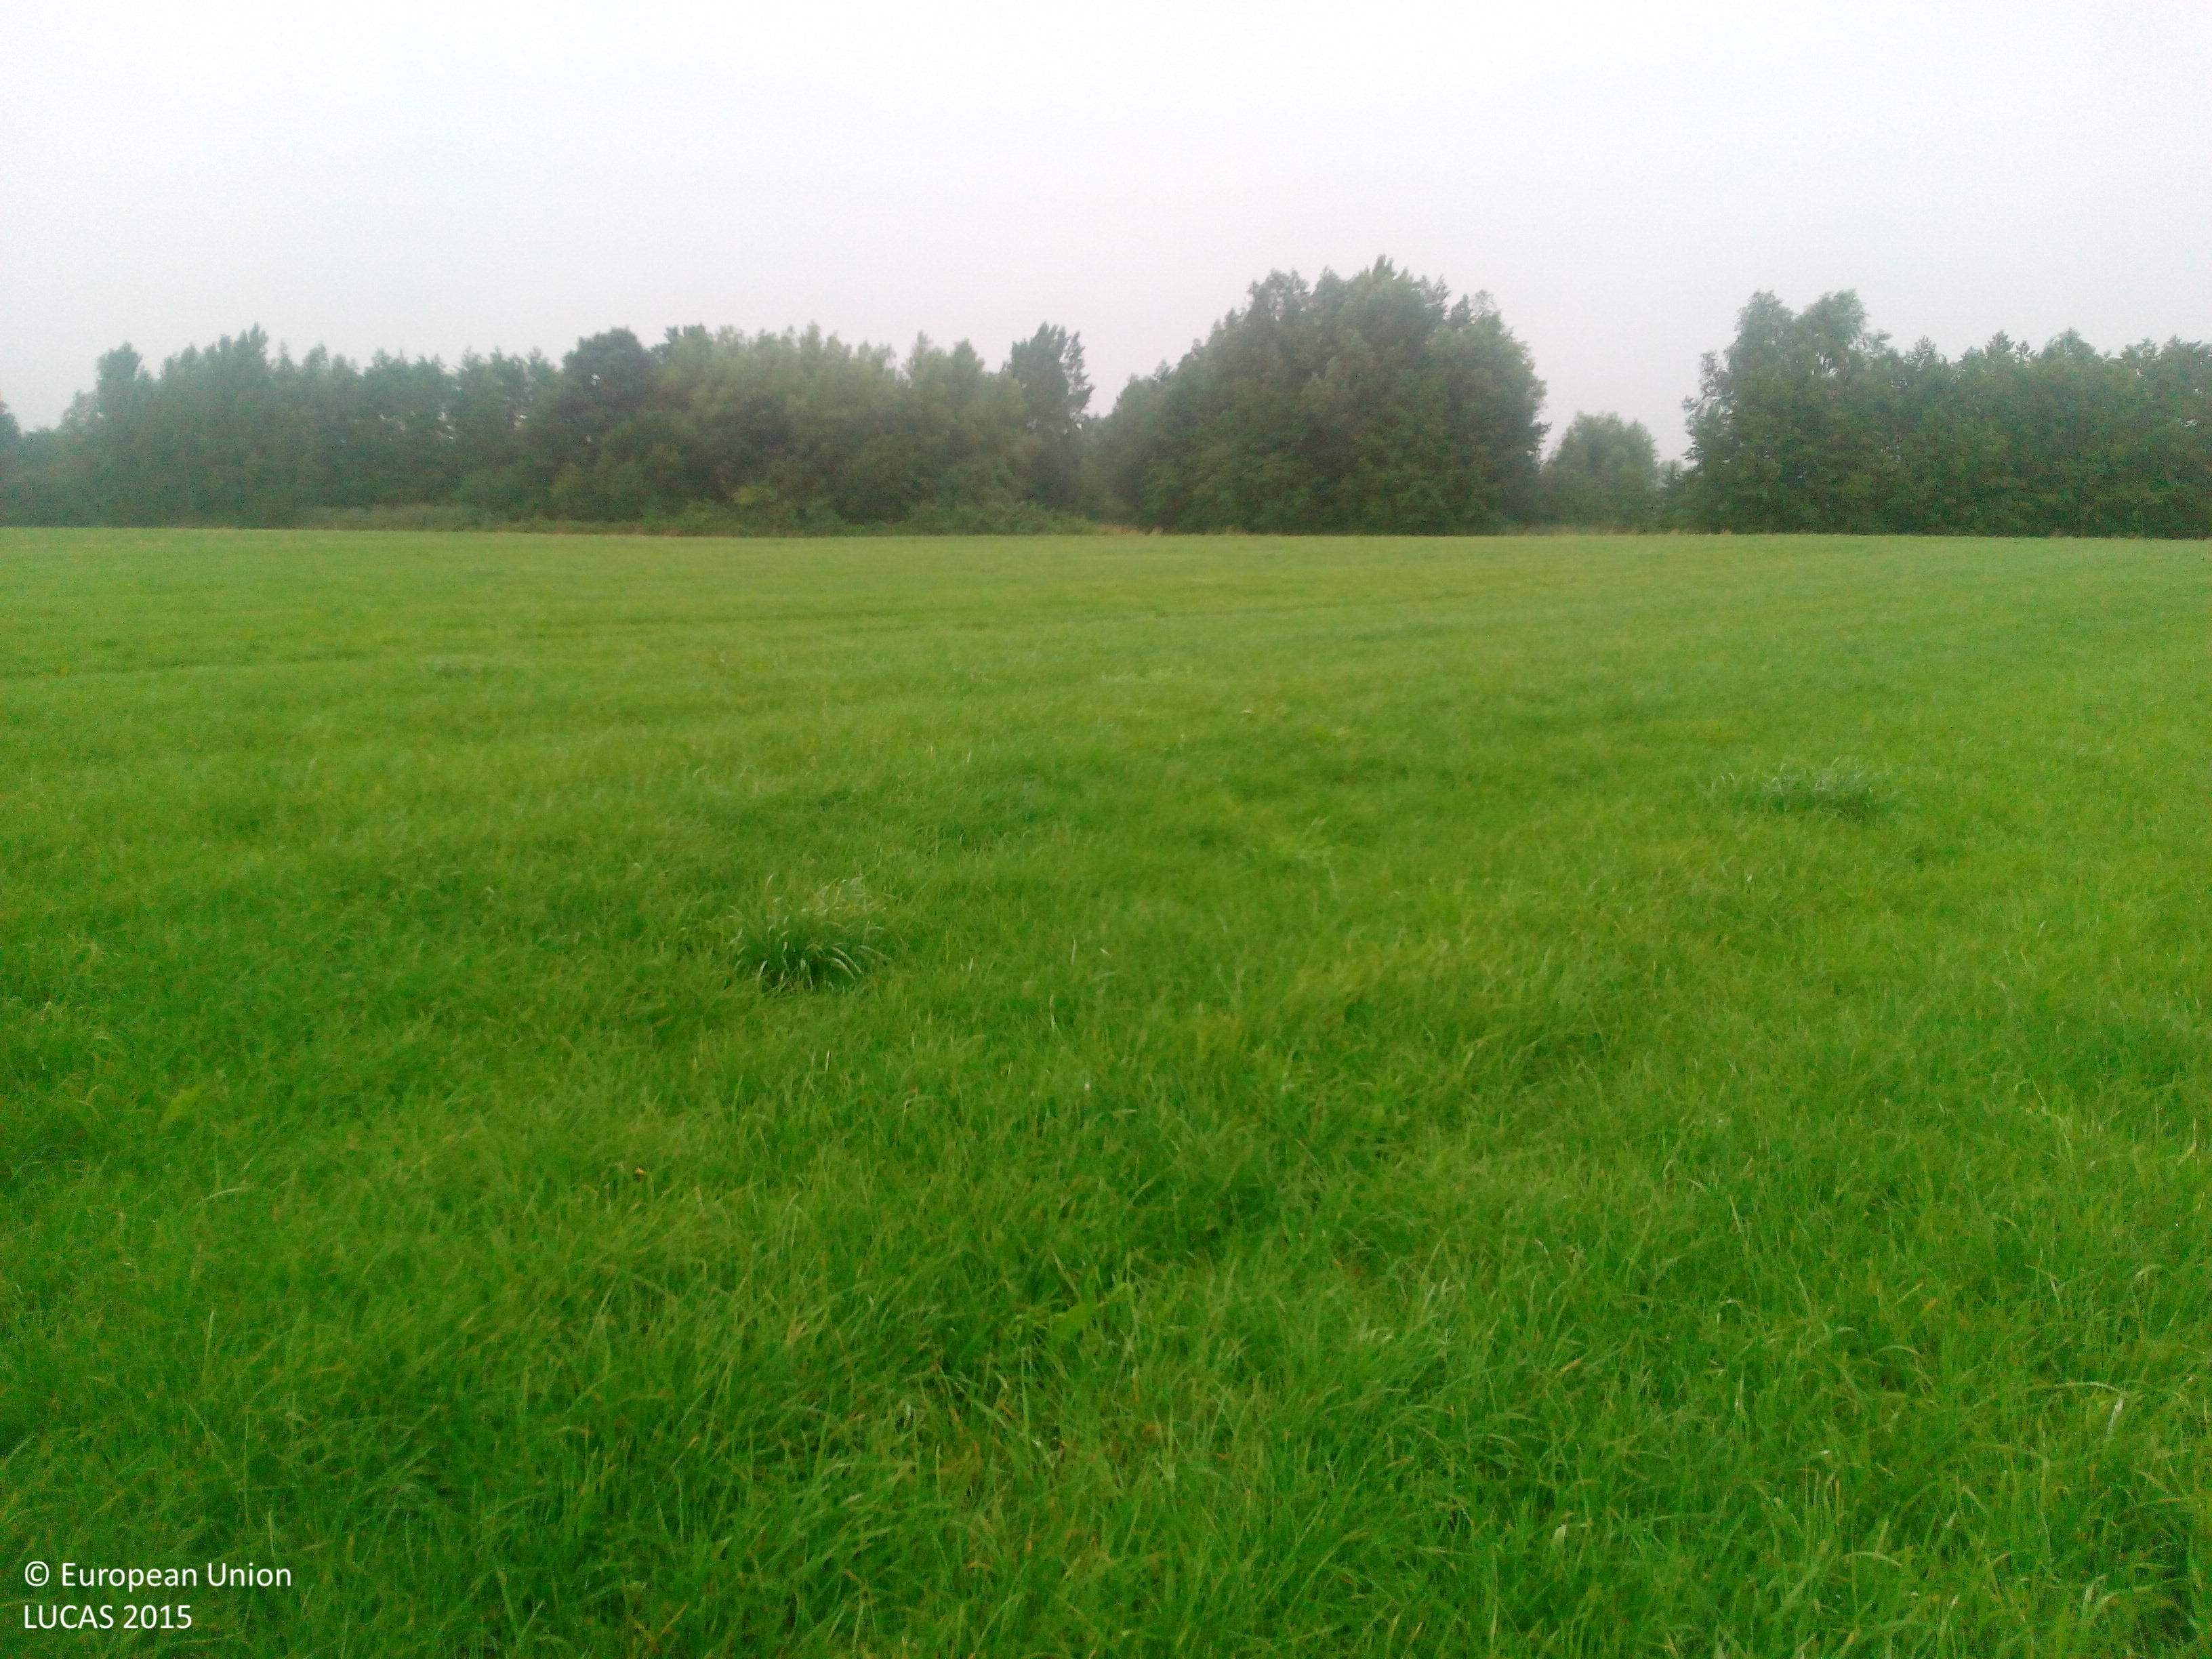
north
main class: Cropland
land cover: Maize
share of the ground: > 75 %
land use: Agriculture (excluding fallow land and kitchen gardens)
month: July
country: NL
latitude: 51.9955
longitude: 6.2855
